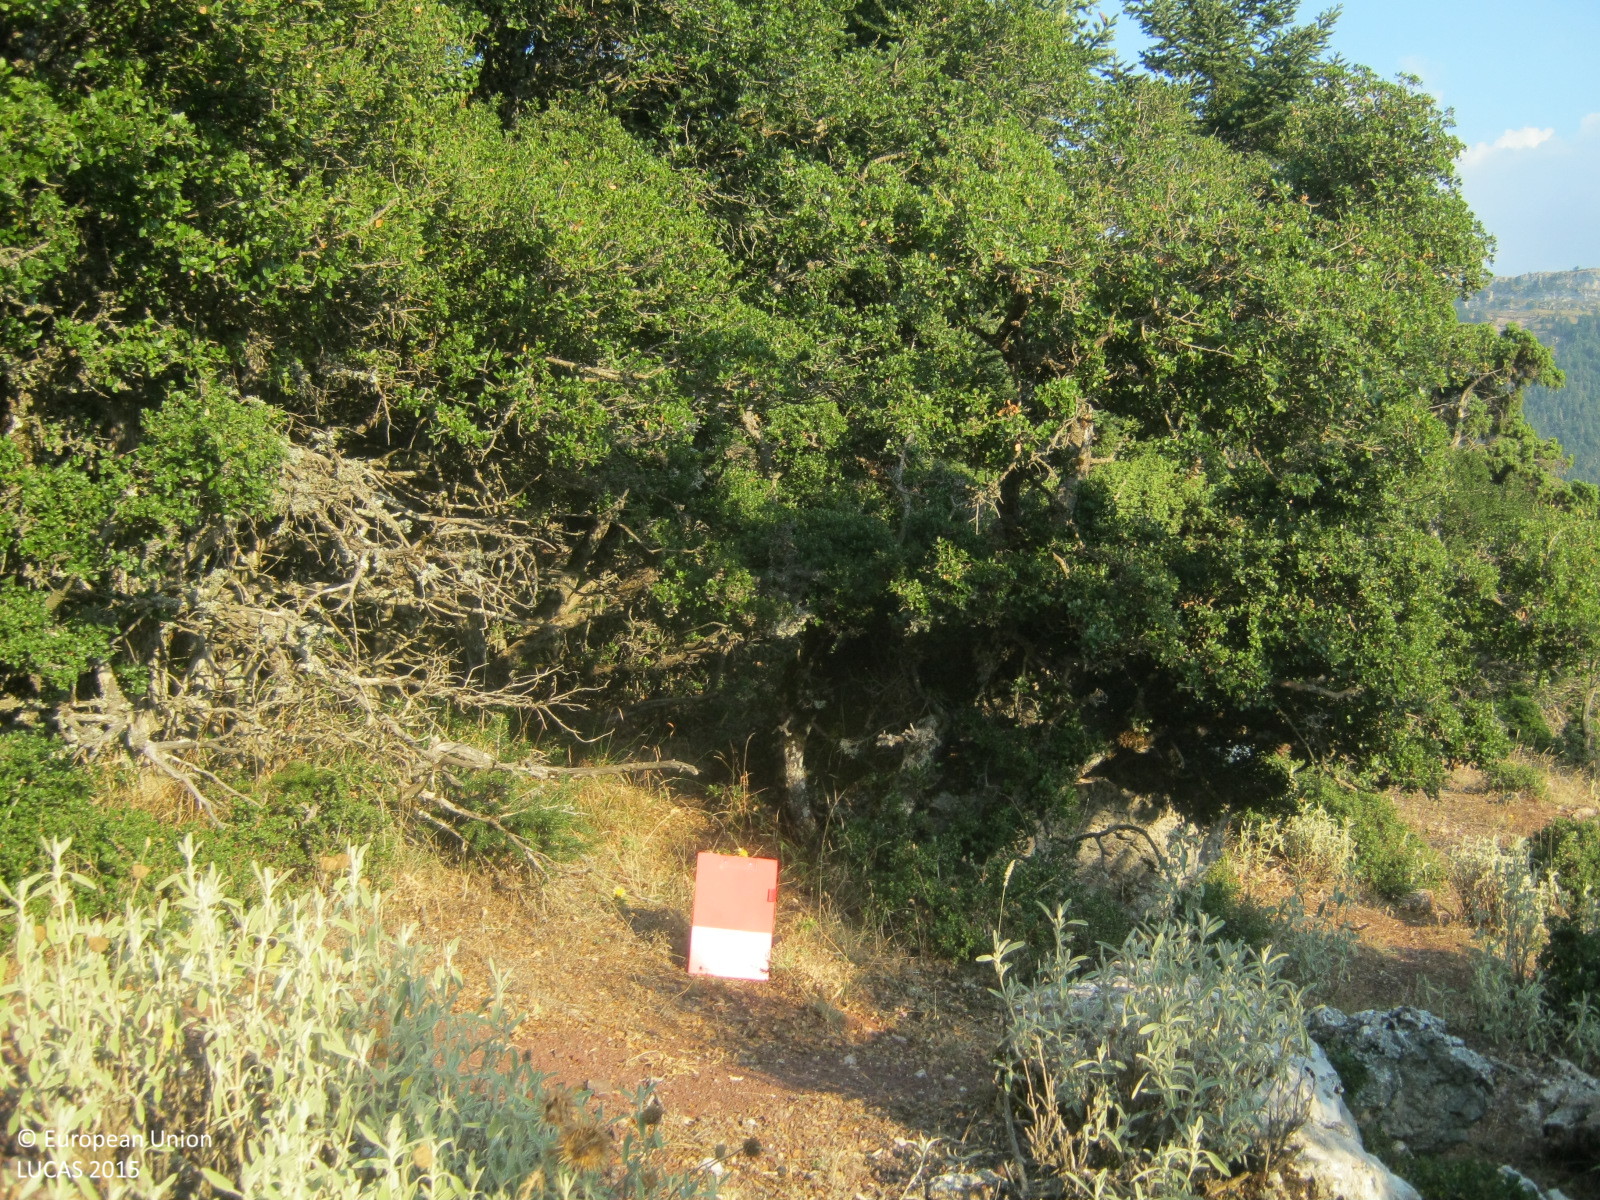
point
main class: Woodland
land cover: Spruce dominated mixed woodland
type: coniferous forest of the mediterranean region
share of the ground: 50 - 75 %
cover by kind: coniferous forest trees 45 %, broadleaved forest trees 25 %, shrubs 10 %, herbaceous plants 10 %, unconsolidated bare surface 10 %
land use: Forestry
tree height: > 5 m
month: September
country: GR
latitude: 38.0431
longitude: 22.1713
